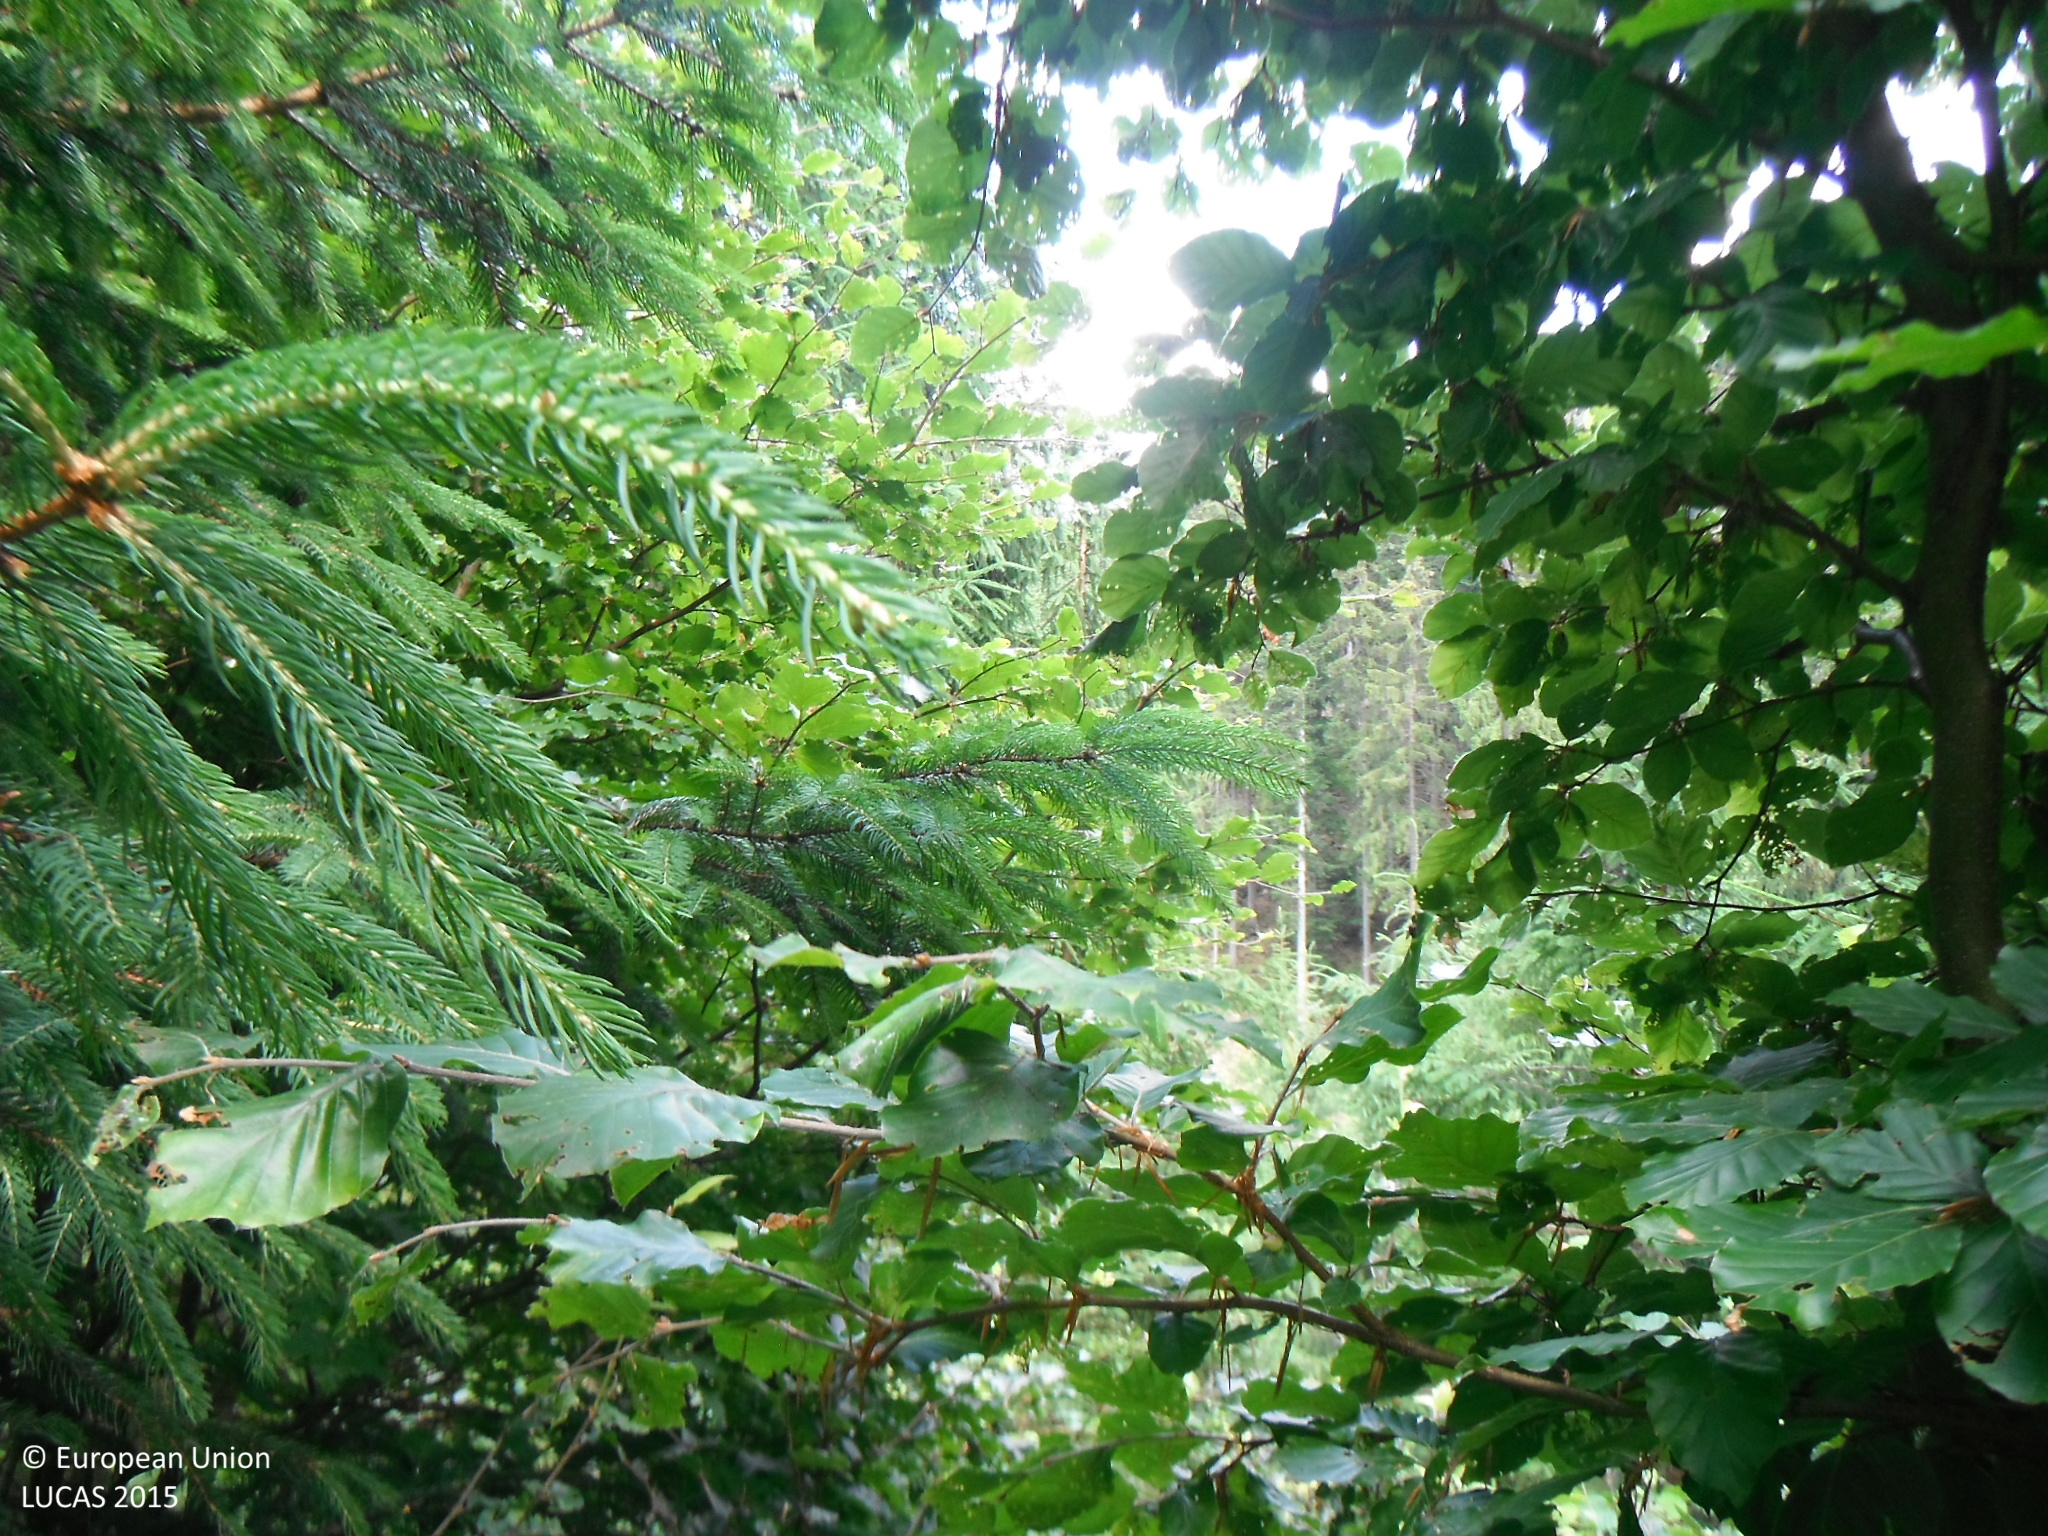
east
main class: Shrubland
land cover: Shrubland with sparse tree cover
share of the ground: > 75 %
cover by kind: shrubs 60 %, herbaceous plants 35 %, coniferous forest trees 5 %
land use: Forestry
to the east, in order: Shrubland with sparse tree cover; Spruce dominated coniferous woodland; Rivers and streams; Spontaneously vegetated surfaces; Paved roads, cycling and walking lanes; Shruby margins; Spruce dominated mixed woodland; Spruce dominated coniferous woodland
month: July
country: SK
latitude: 49.2938
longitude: 18.4189
